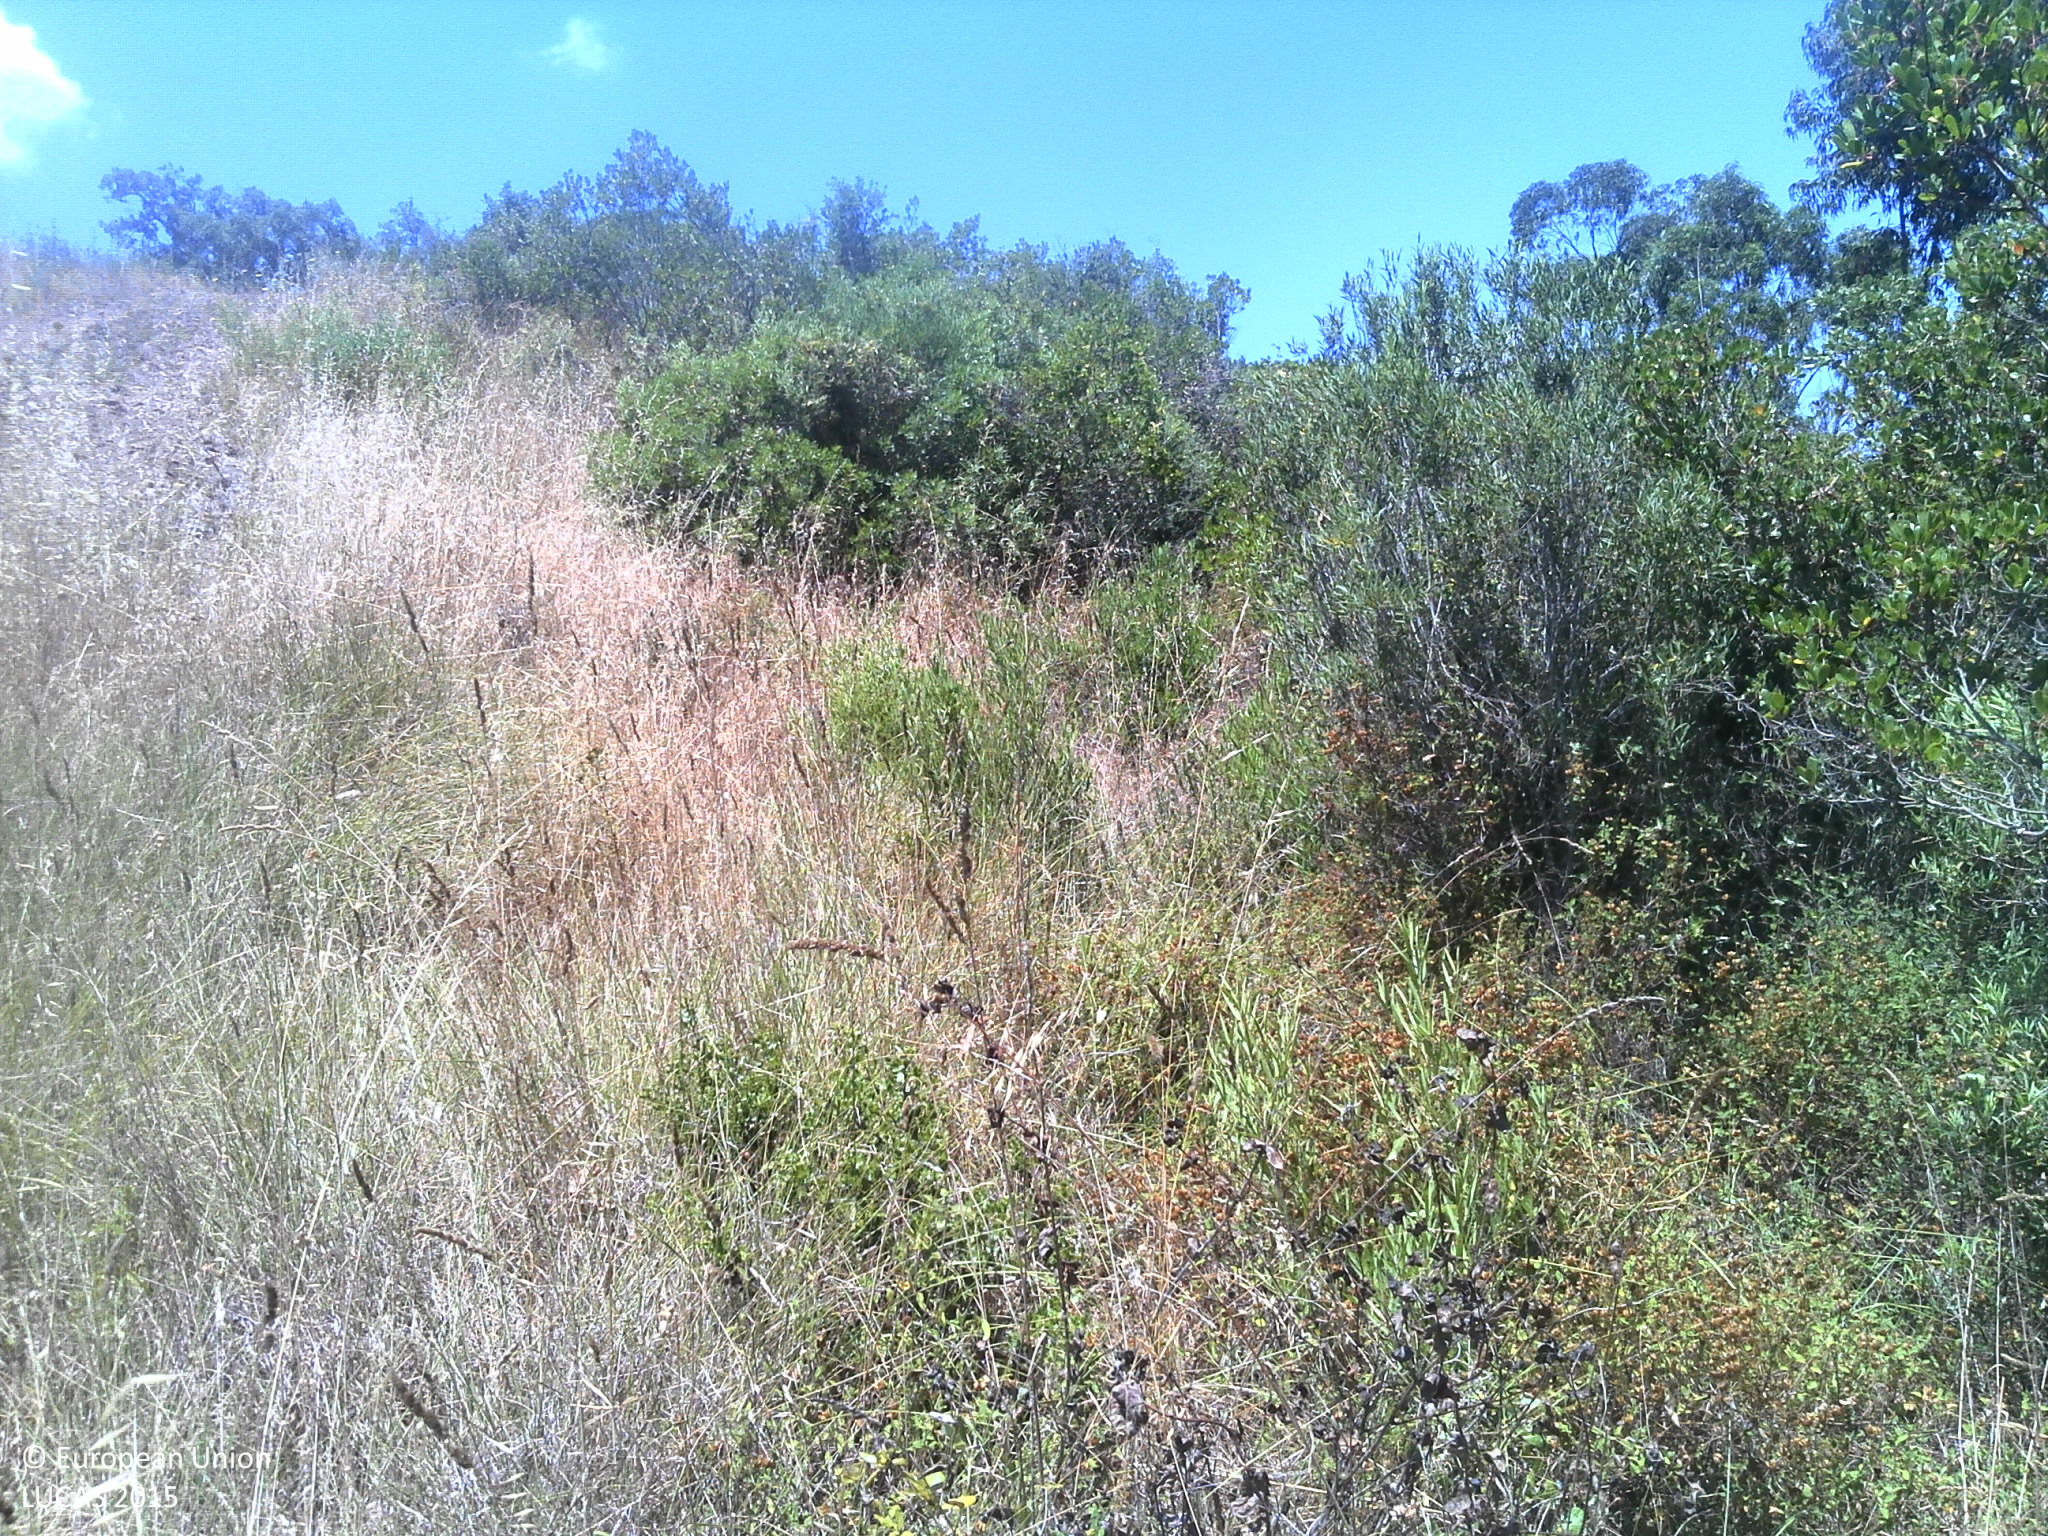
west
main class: Woodland
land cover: Broadleaved woodland
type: broadleaved evergreen forest
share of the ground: 25 - 50 %
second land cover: Shrubland without tree cover
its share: 25 - 50 %
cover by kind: broadleaved forest trees 30 %, herbaceous plants 30 %, shrubs 20 %, unconsolidated bare surface 20 %
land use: Forestry
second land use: Agriculture (excluding fallow land and kitchen gardens)
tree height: > 5 m
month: June
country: PT
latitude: 37.9599
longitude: -8.5619
